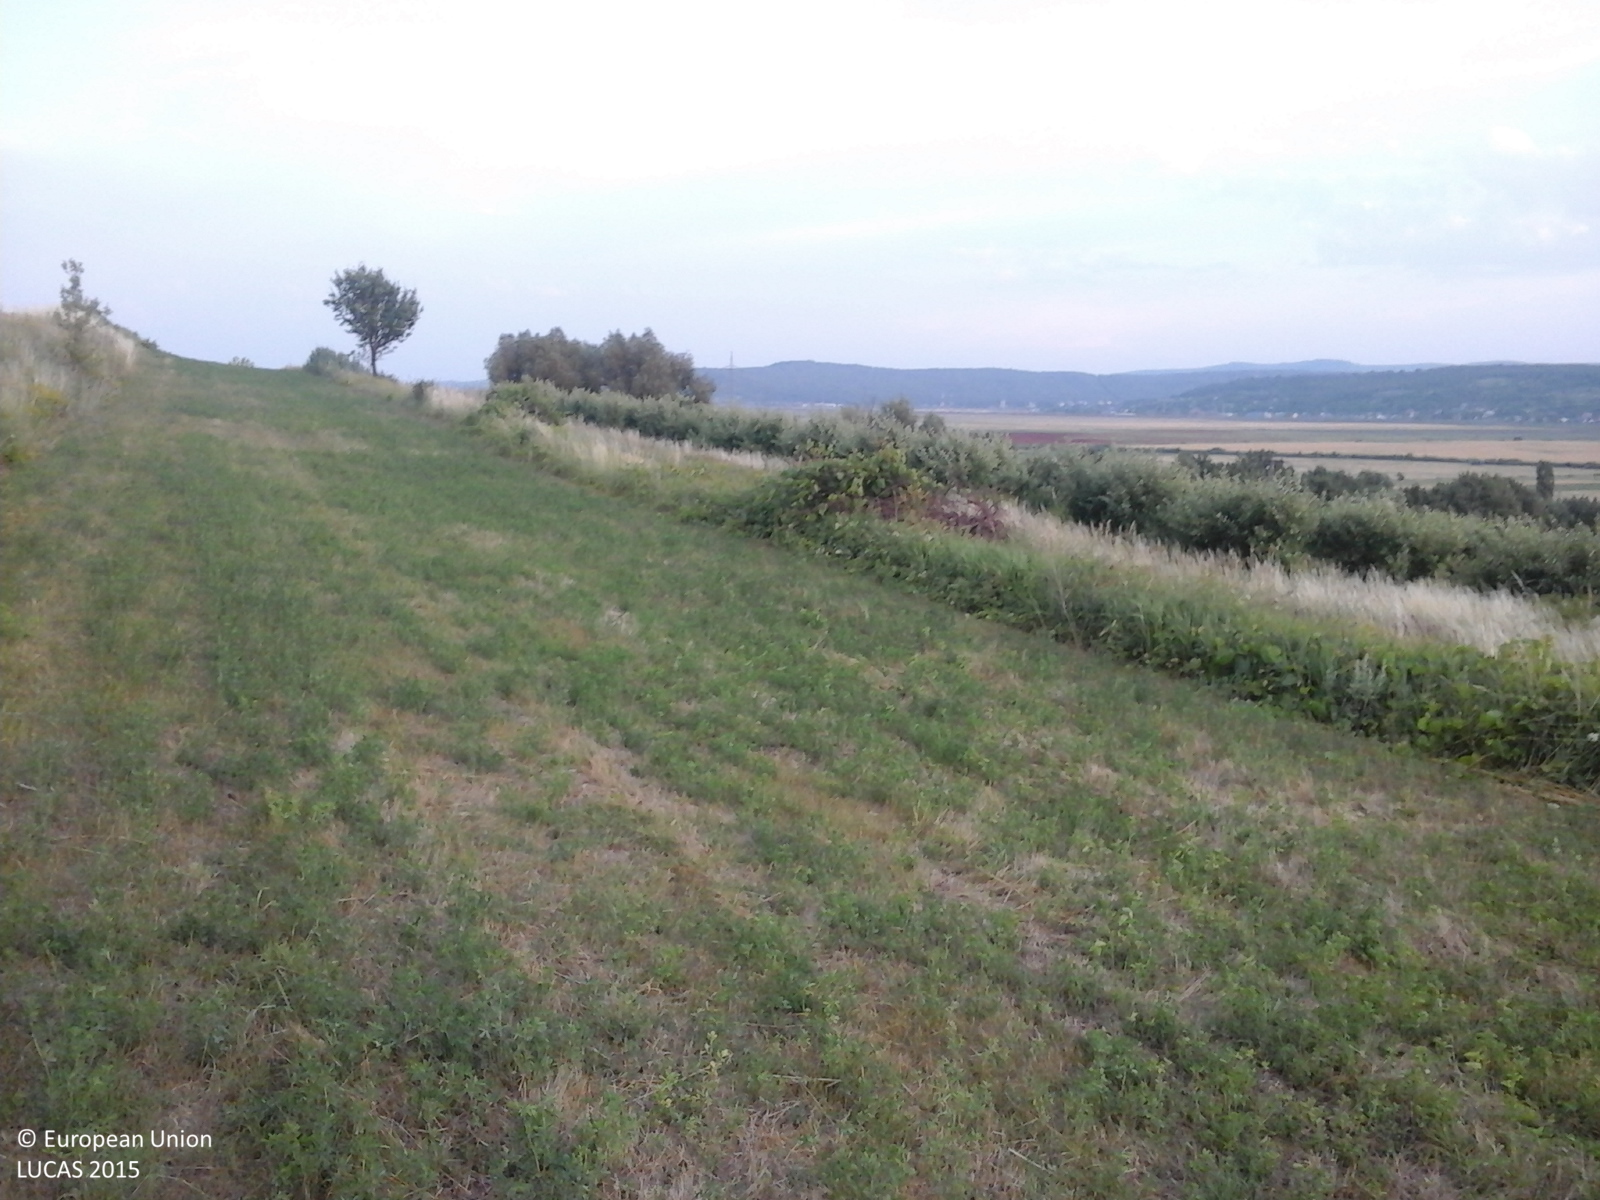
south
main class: Cropland
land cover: Lucerne
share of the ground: > 75 %
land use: Agriculture (excluding fallow land and kitchen gardens)
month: June
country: RO
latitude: 46.6657
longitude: 27.6972
